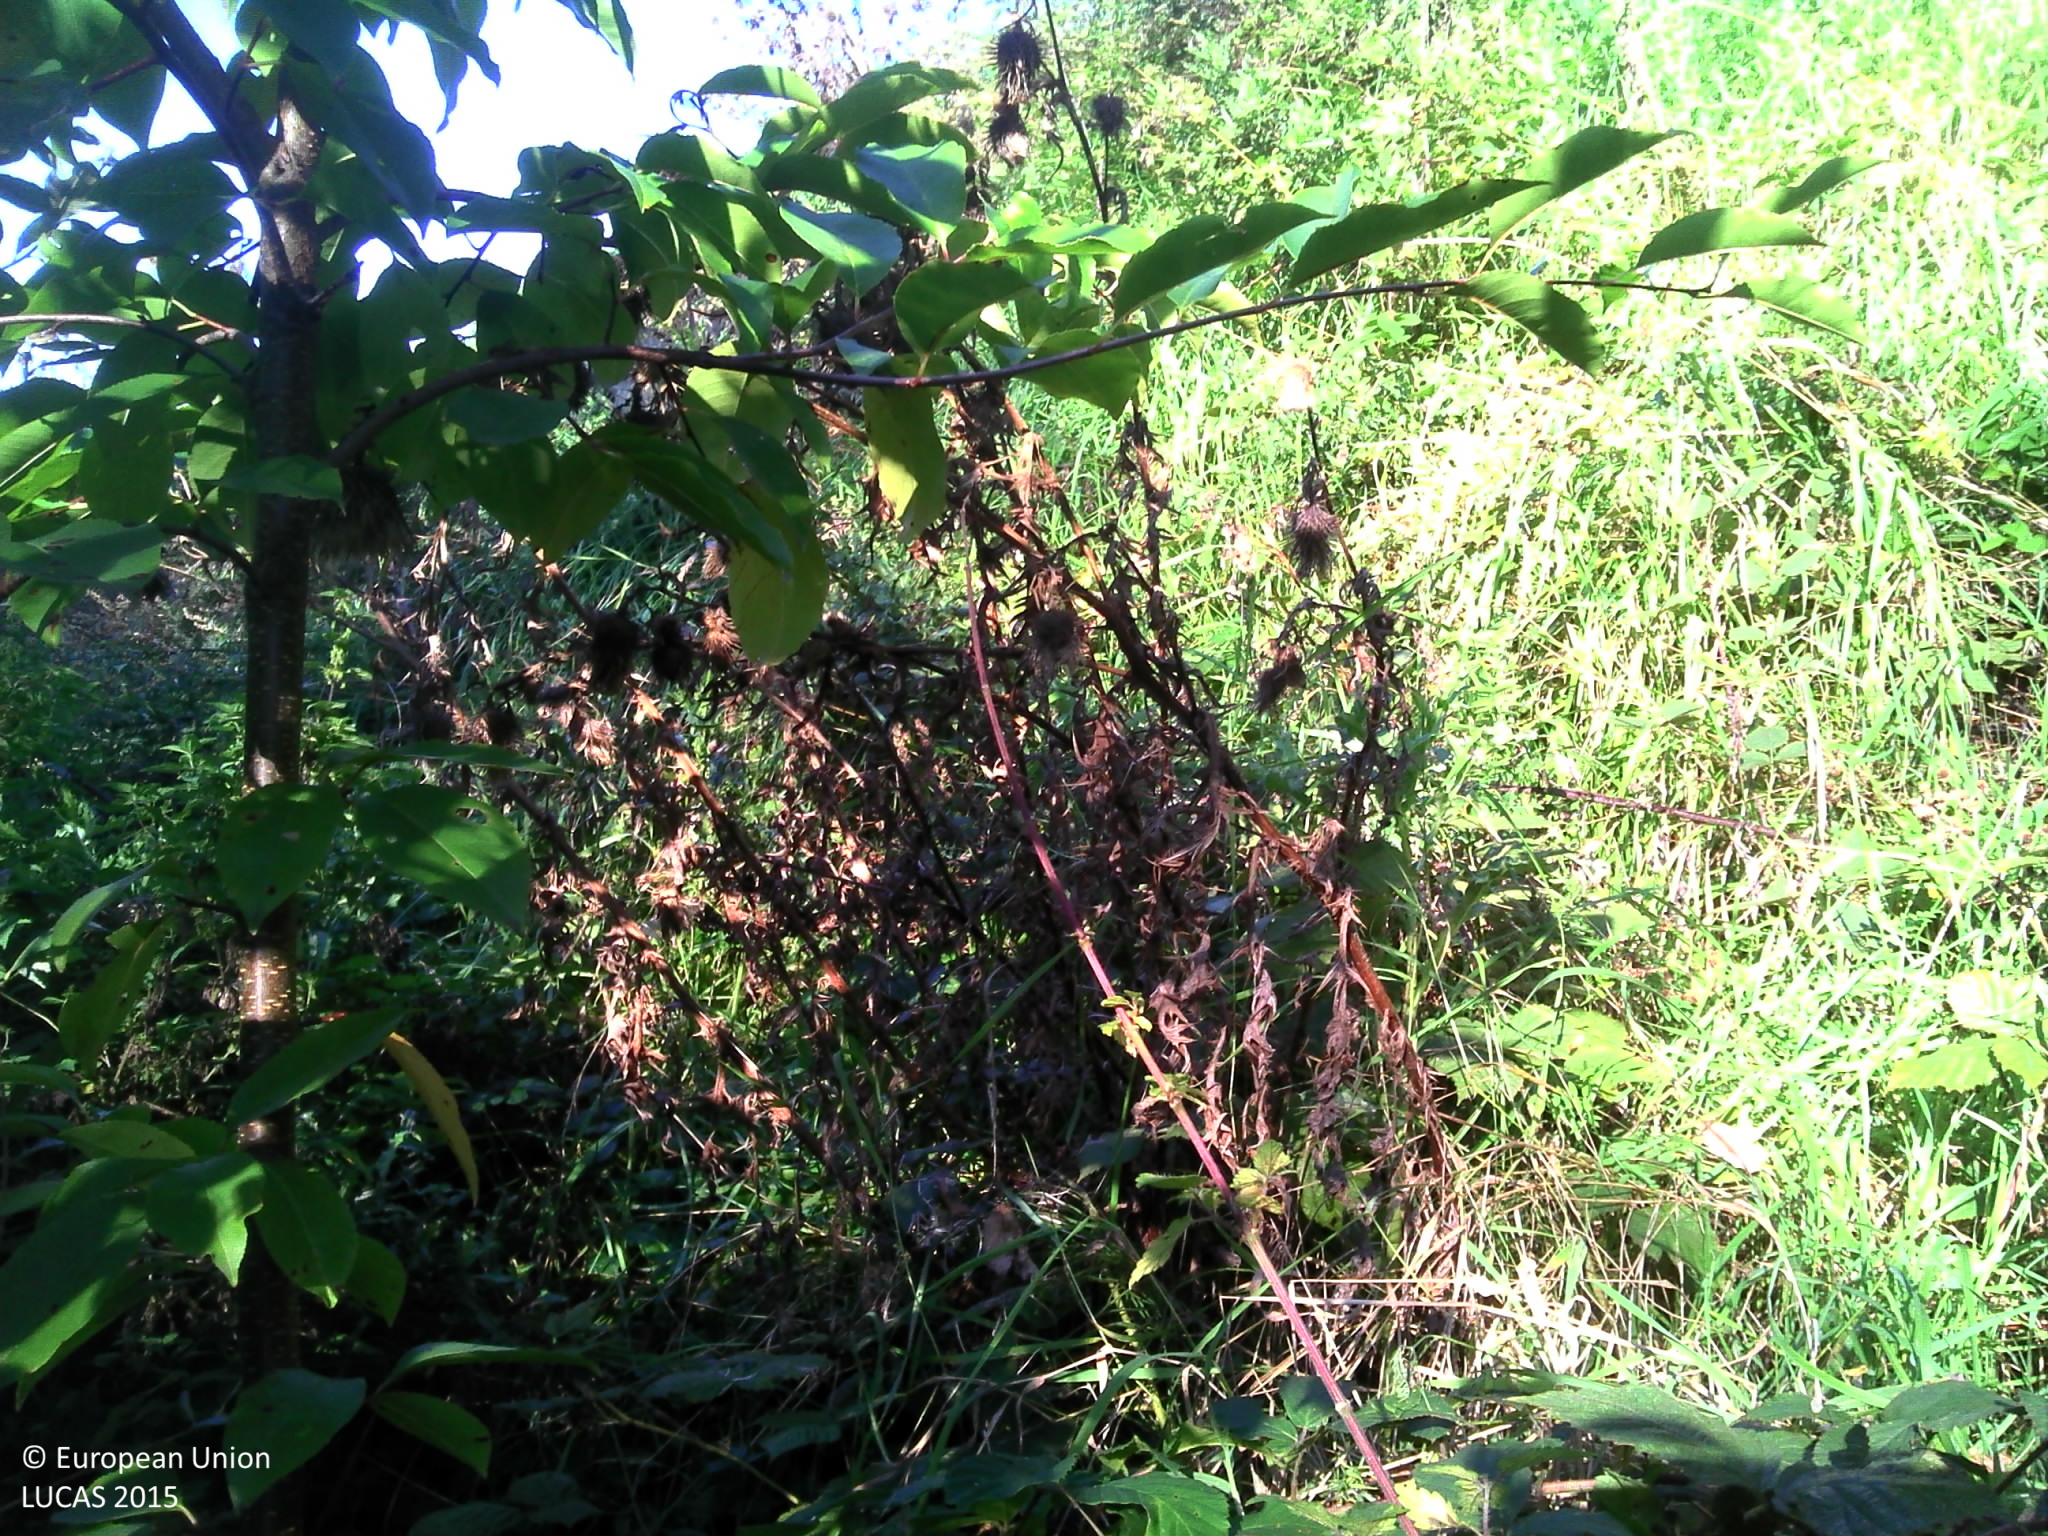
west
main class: Cropland
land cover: Apple fruit
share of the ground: > 75 %
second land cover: Grassland without tree/shrub cover
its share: > 75 %
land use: Agriculture (excluding fallow land and kitchen gardens)
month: September
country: BE
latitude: 51.1943
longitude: 4.6587
